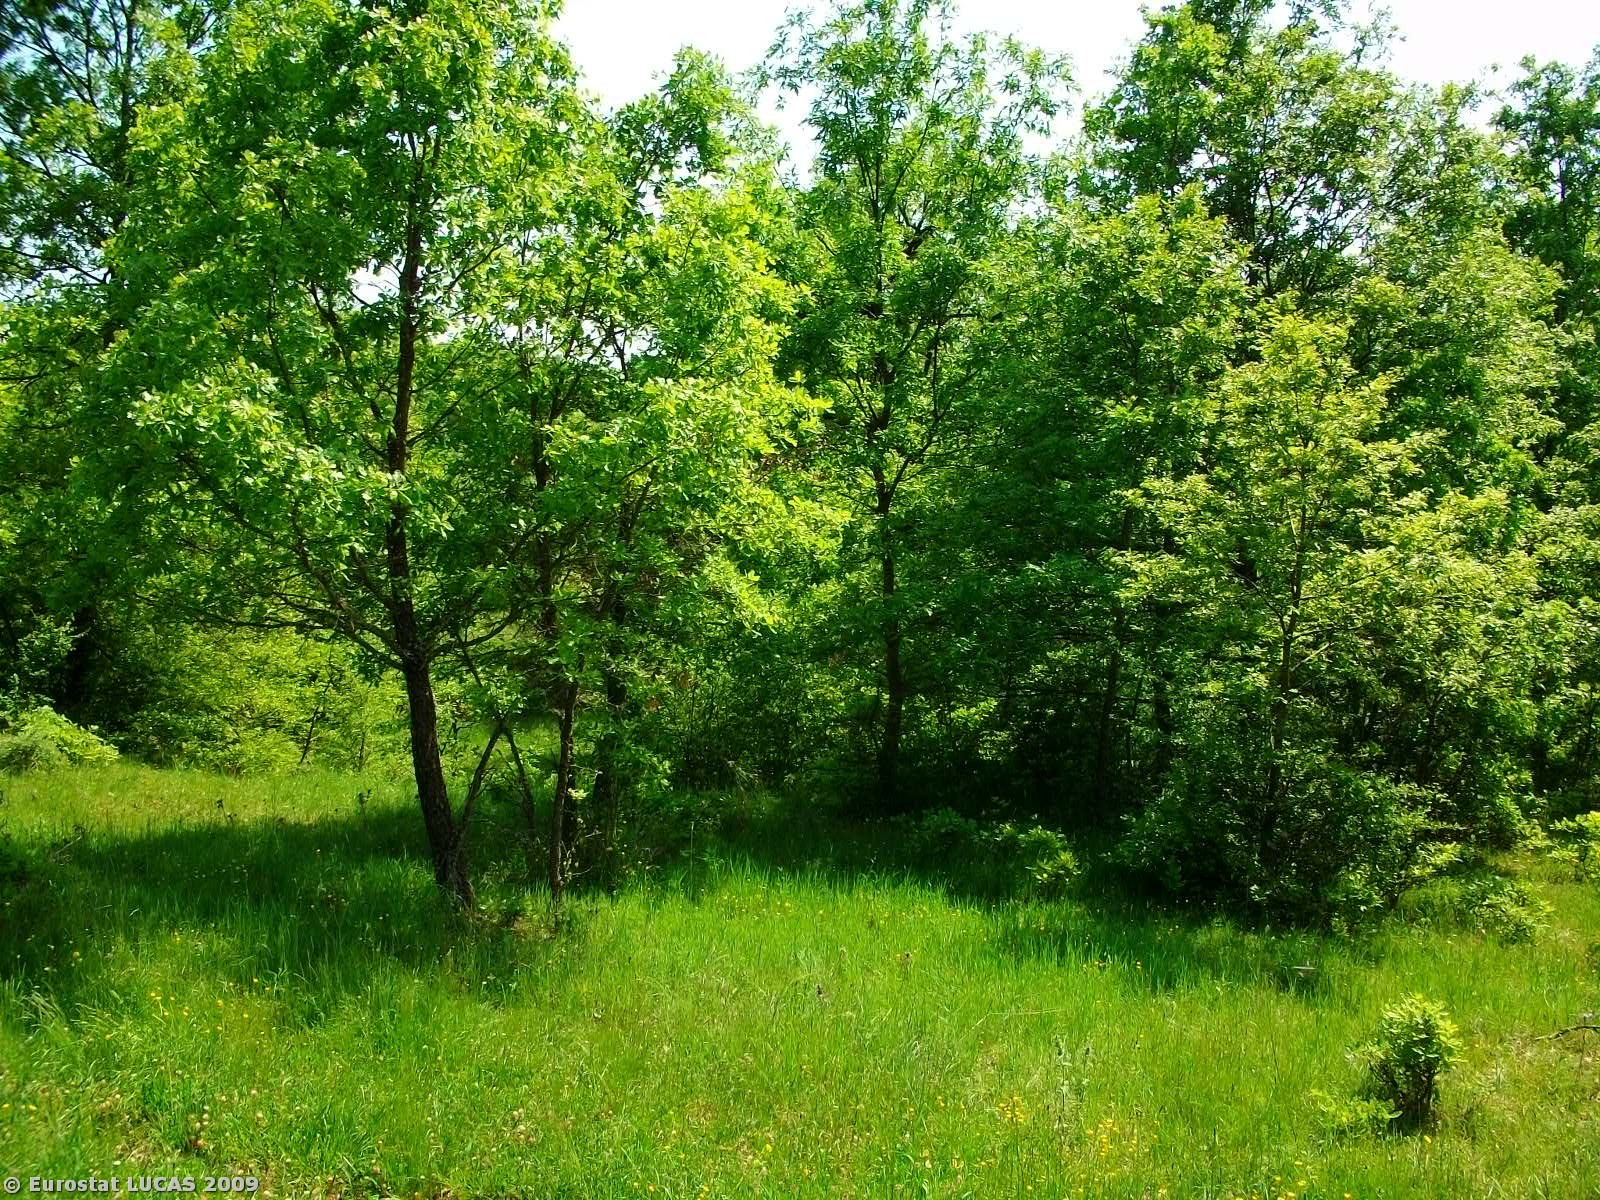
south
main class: Woodland
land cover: Broadleaved woodland
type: thermophilous deciduous forest
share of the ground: 25 - 50 %
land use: Forestry
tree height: > 5 m
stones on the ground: < 10 %
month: May
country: GR
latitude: 39.9149
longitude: 21.6738
